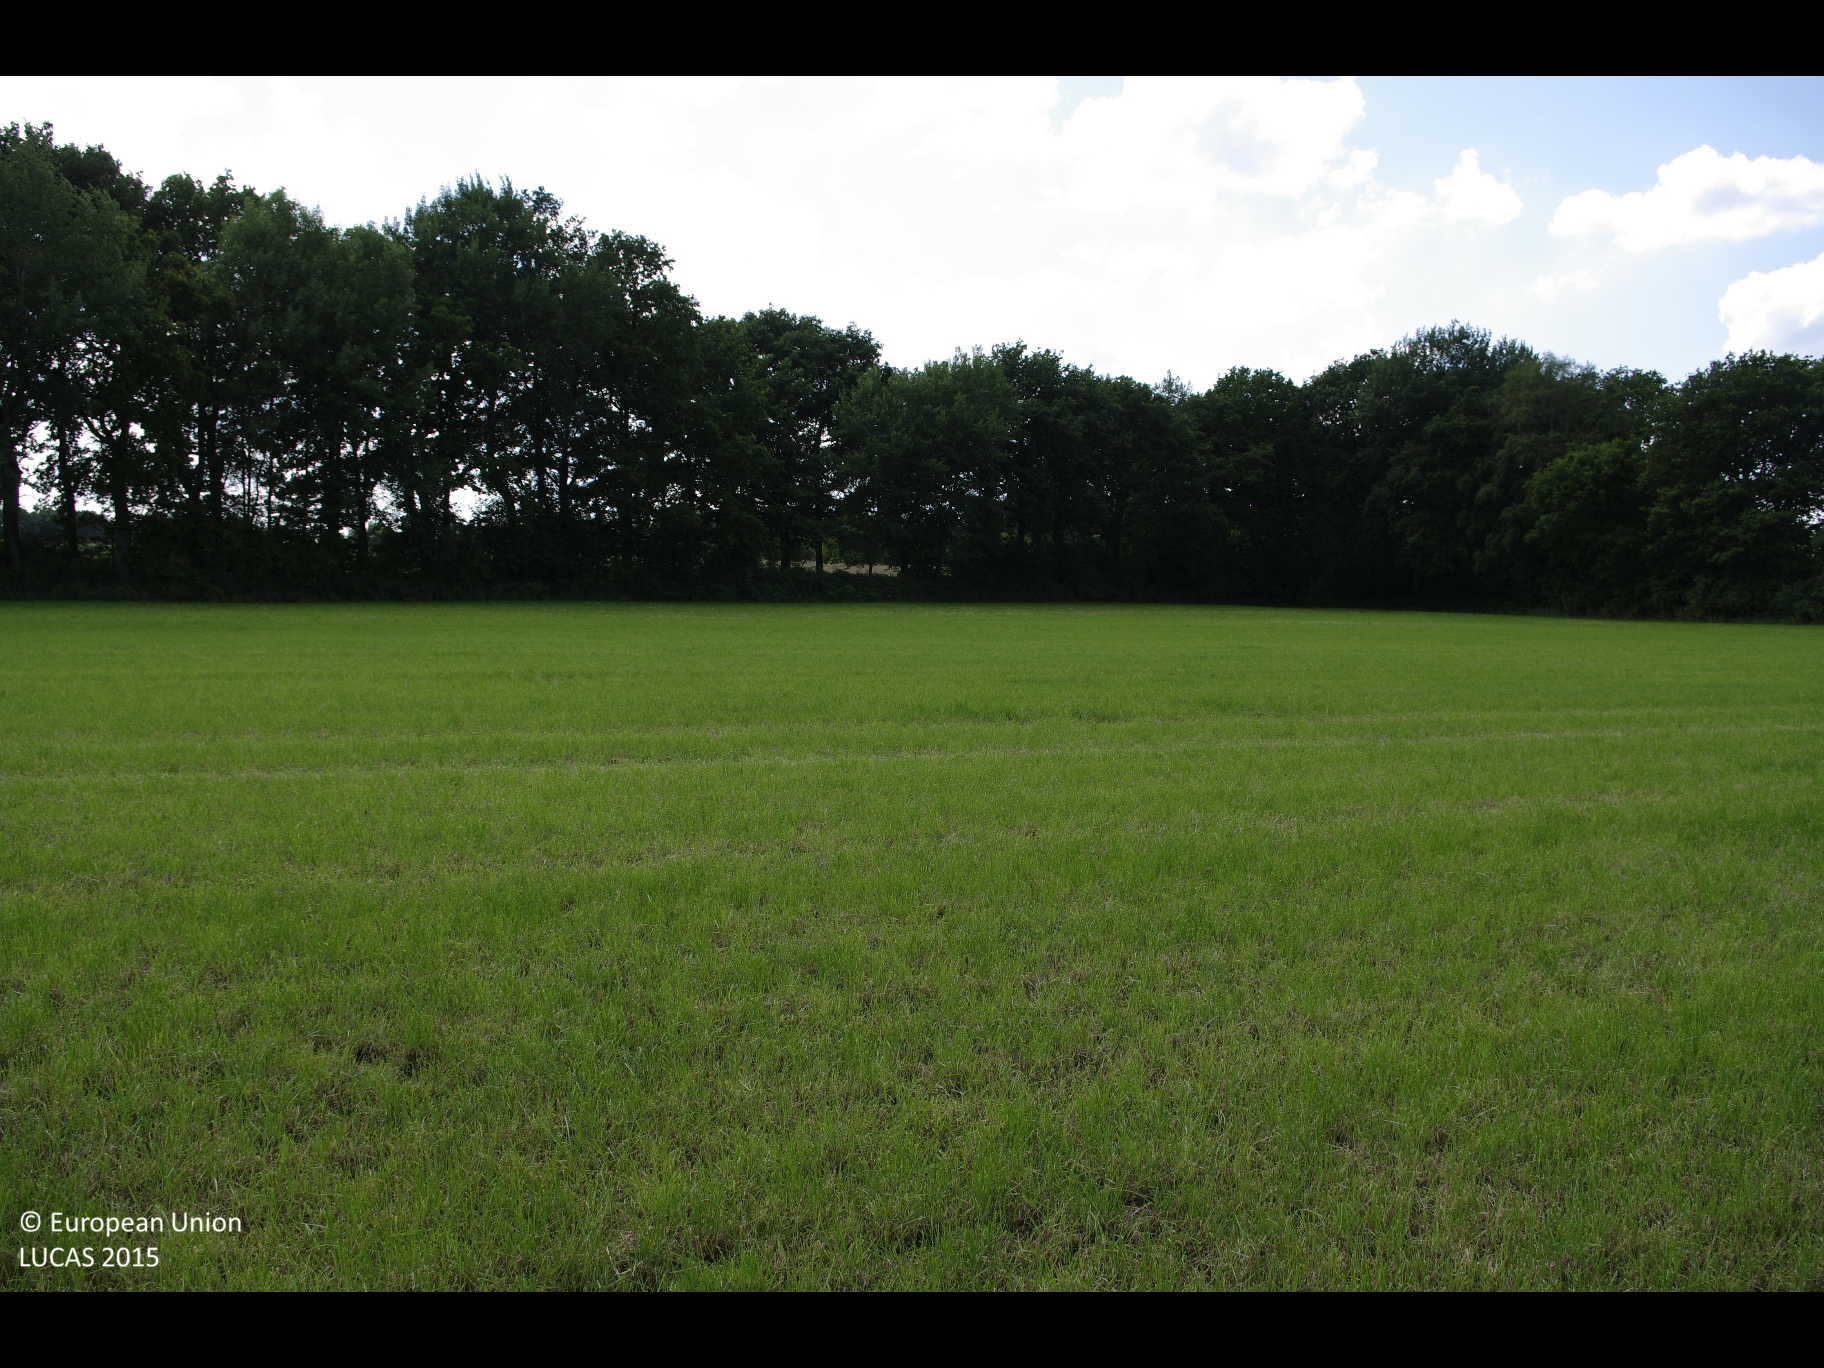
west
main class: Cropland
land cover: Temporary grasslands
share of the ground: > 75 %
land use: Agriculture (excluding fallow land and kitchen gardens)
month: July
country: DE
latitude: 53.8871
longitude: 9.8936
